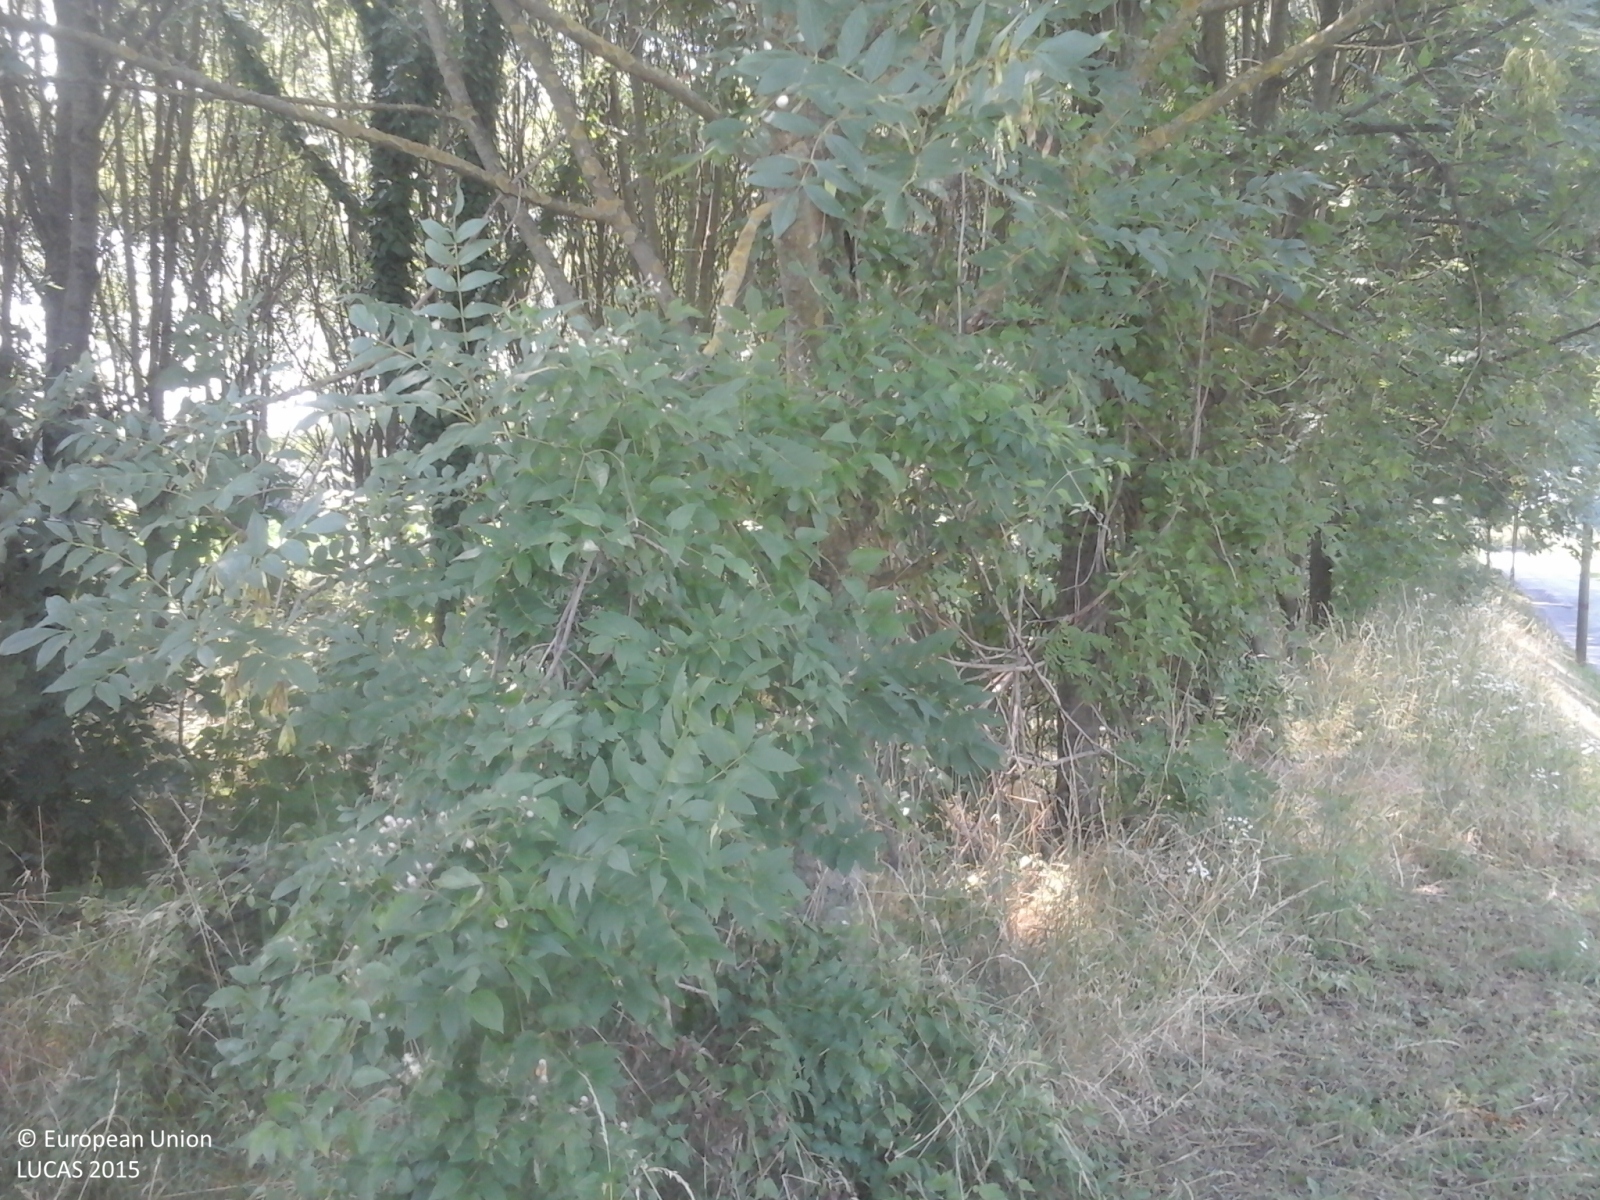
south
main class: Grassland
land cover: Grassland without tree/shrub cover
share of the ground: > 75 %
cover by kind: herbaceous plants 100 %
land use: Agriculture (excluding fallow land and kitchen gardens)
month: July
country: IT
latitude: 45.6470
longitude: 9.4236
